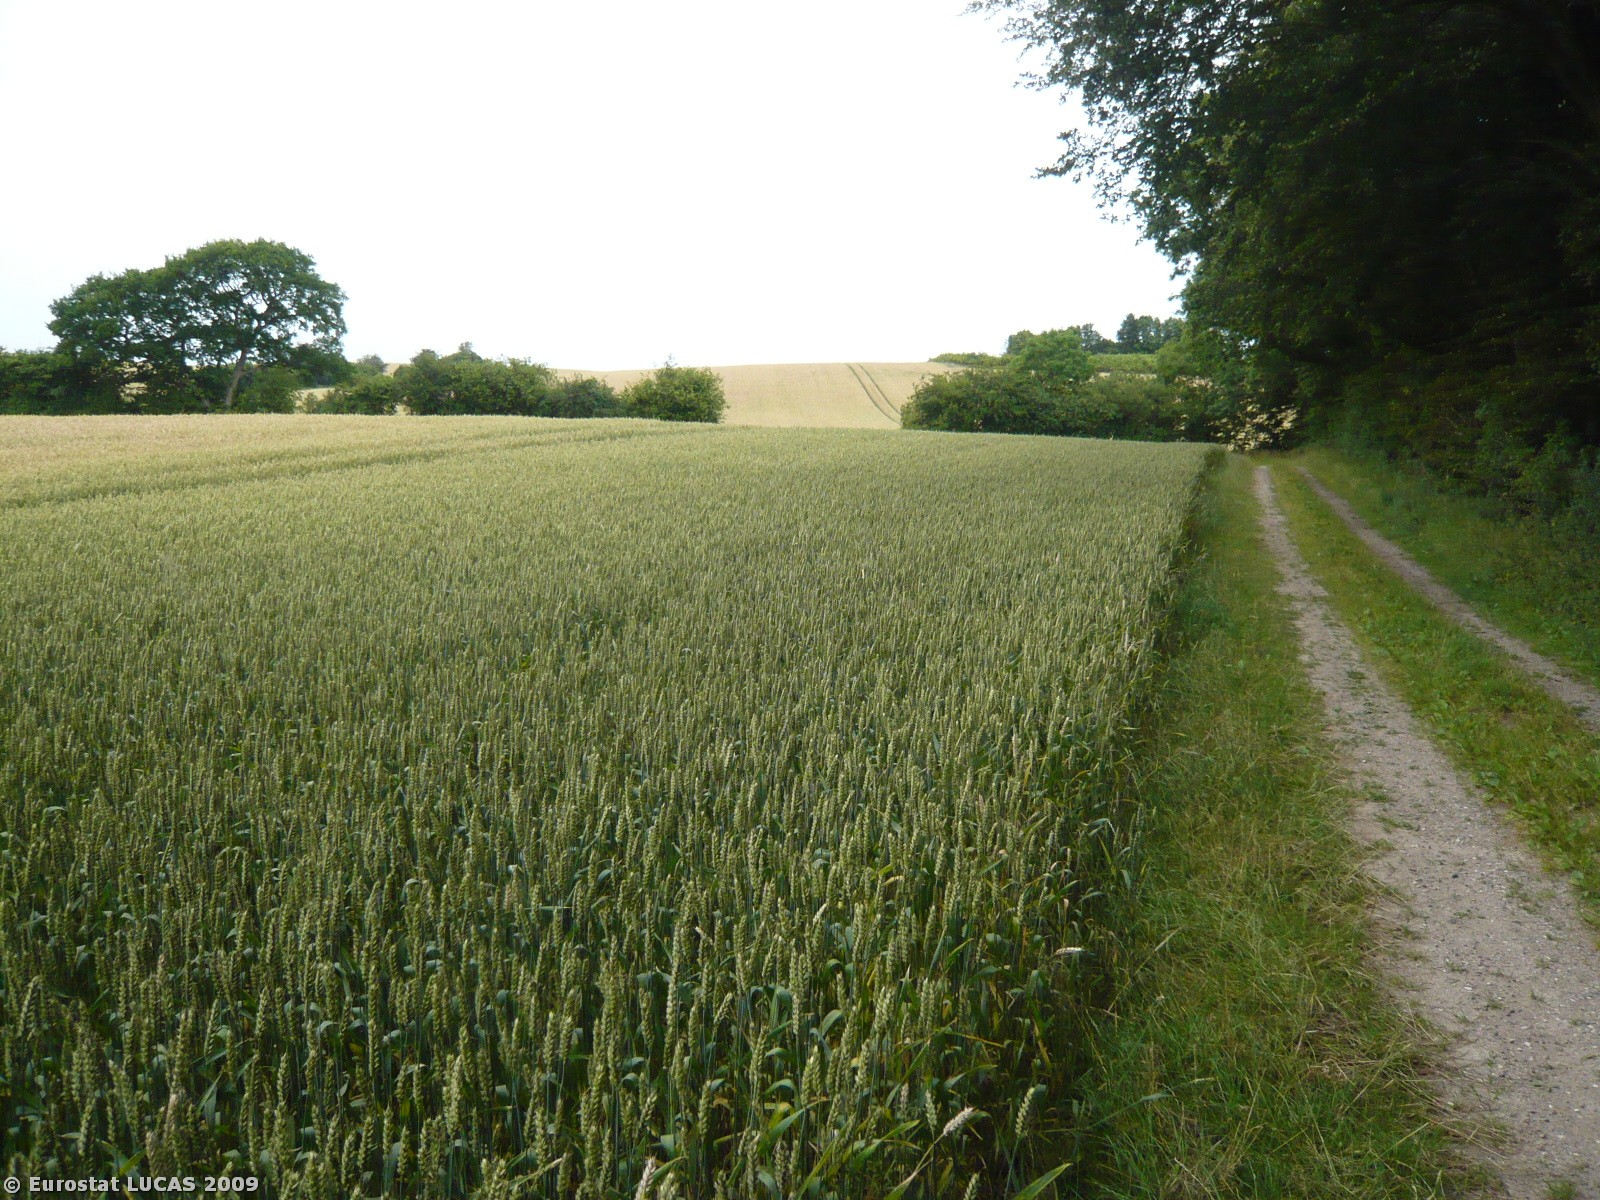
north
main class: Cropland
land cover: Common wheat
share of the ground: > 75 %
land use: Agriculture (excluding fallow land and kitchen gardens)
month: July
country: DK
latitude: 55.5293
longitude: 11.6937
